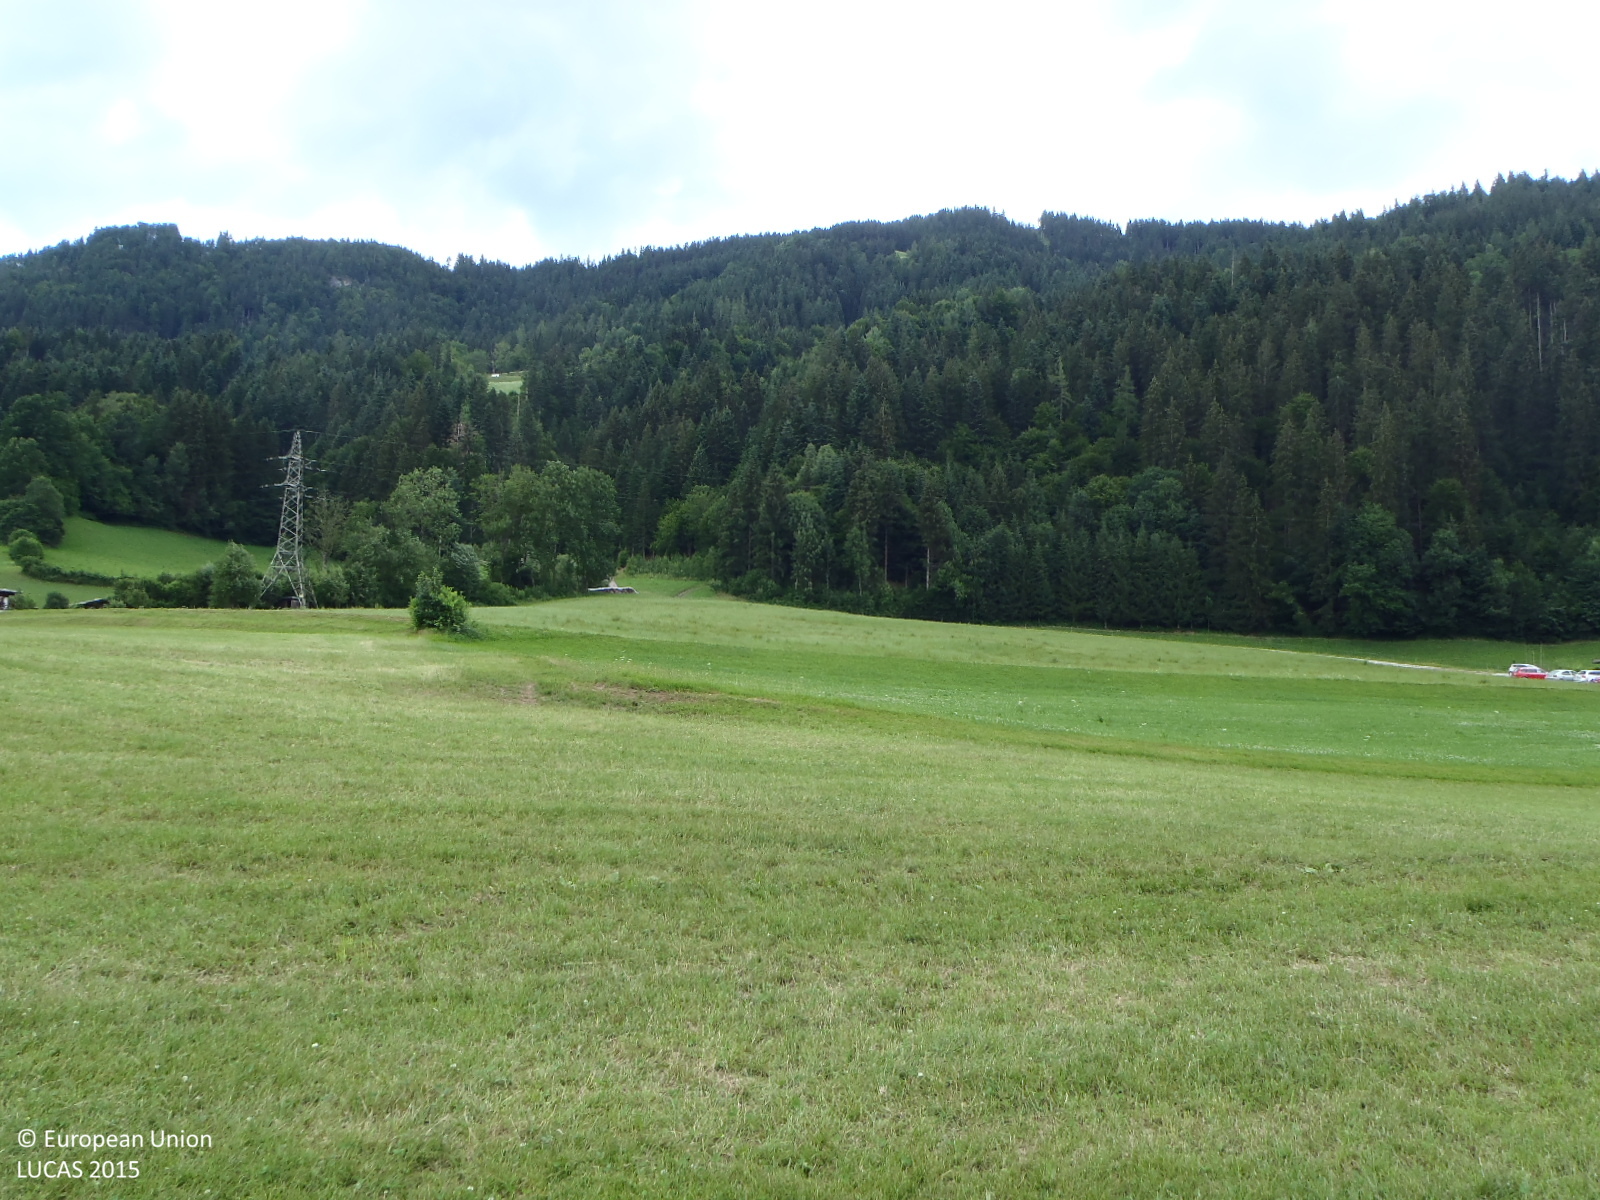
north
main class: Grassland
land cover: Grassland without tree/shrub cover
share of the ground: > 75 %
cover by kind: herbaceous plants 100 %
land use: Agriculture (excluding fallow land and kitchen gardens)
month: July
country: AT
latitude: 47.4827
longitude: 12.1350
